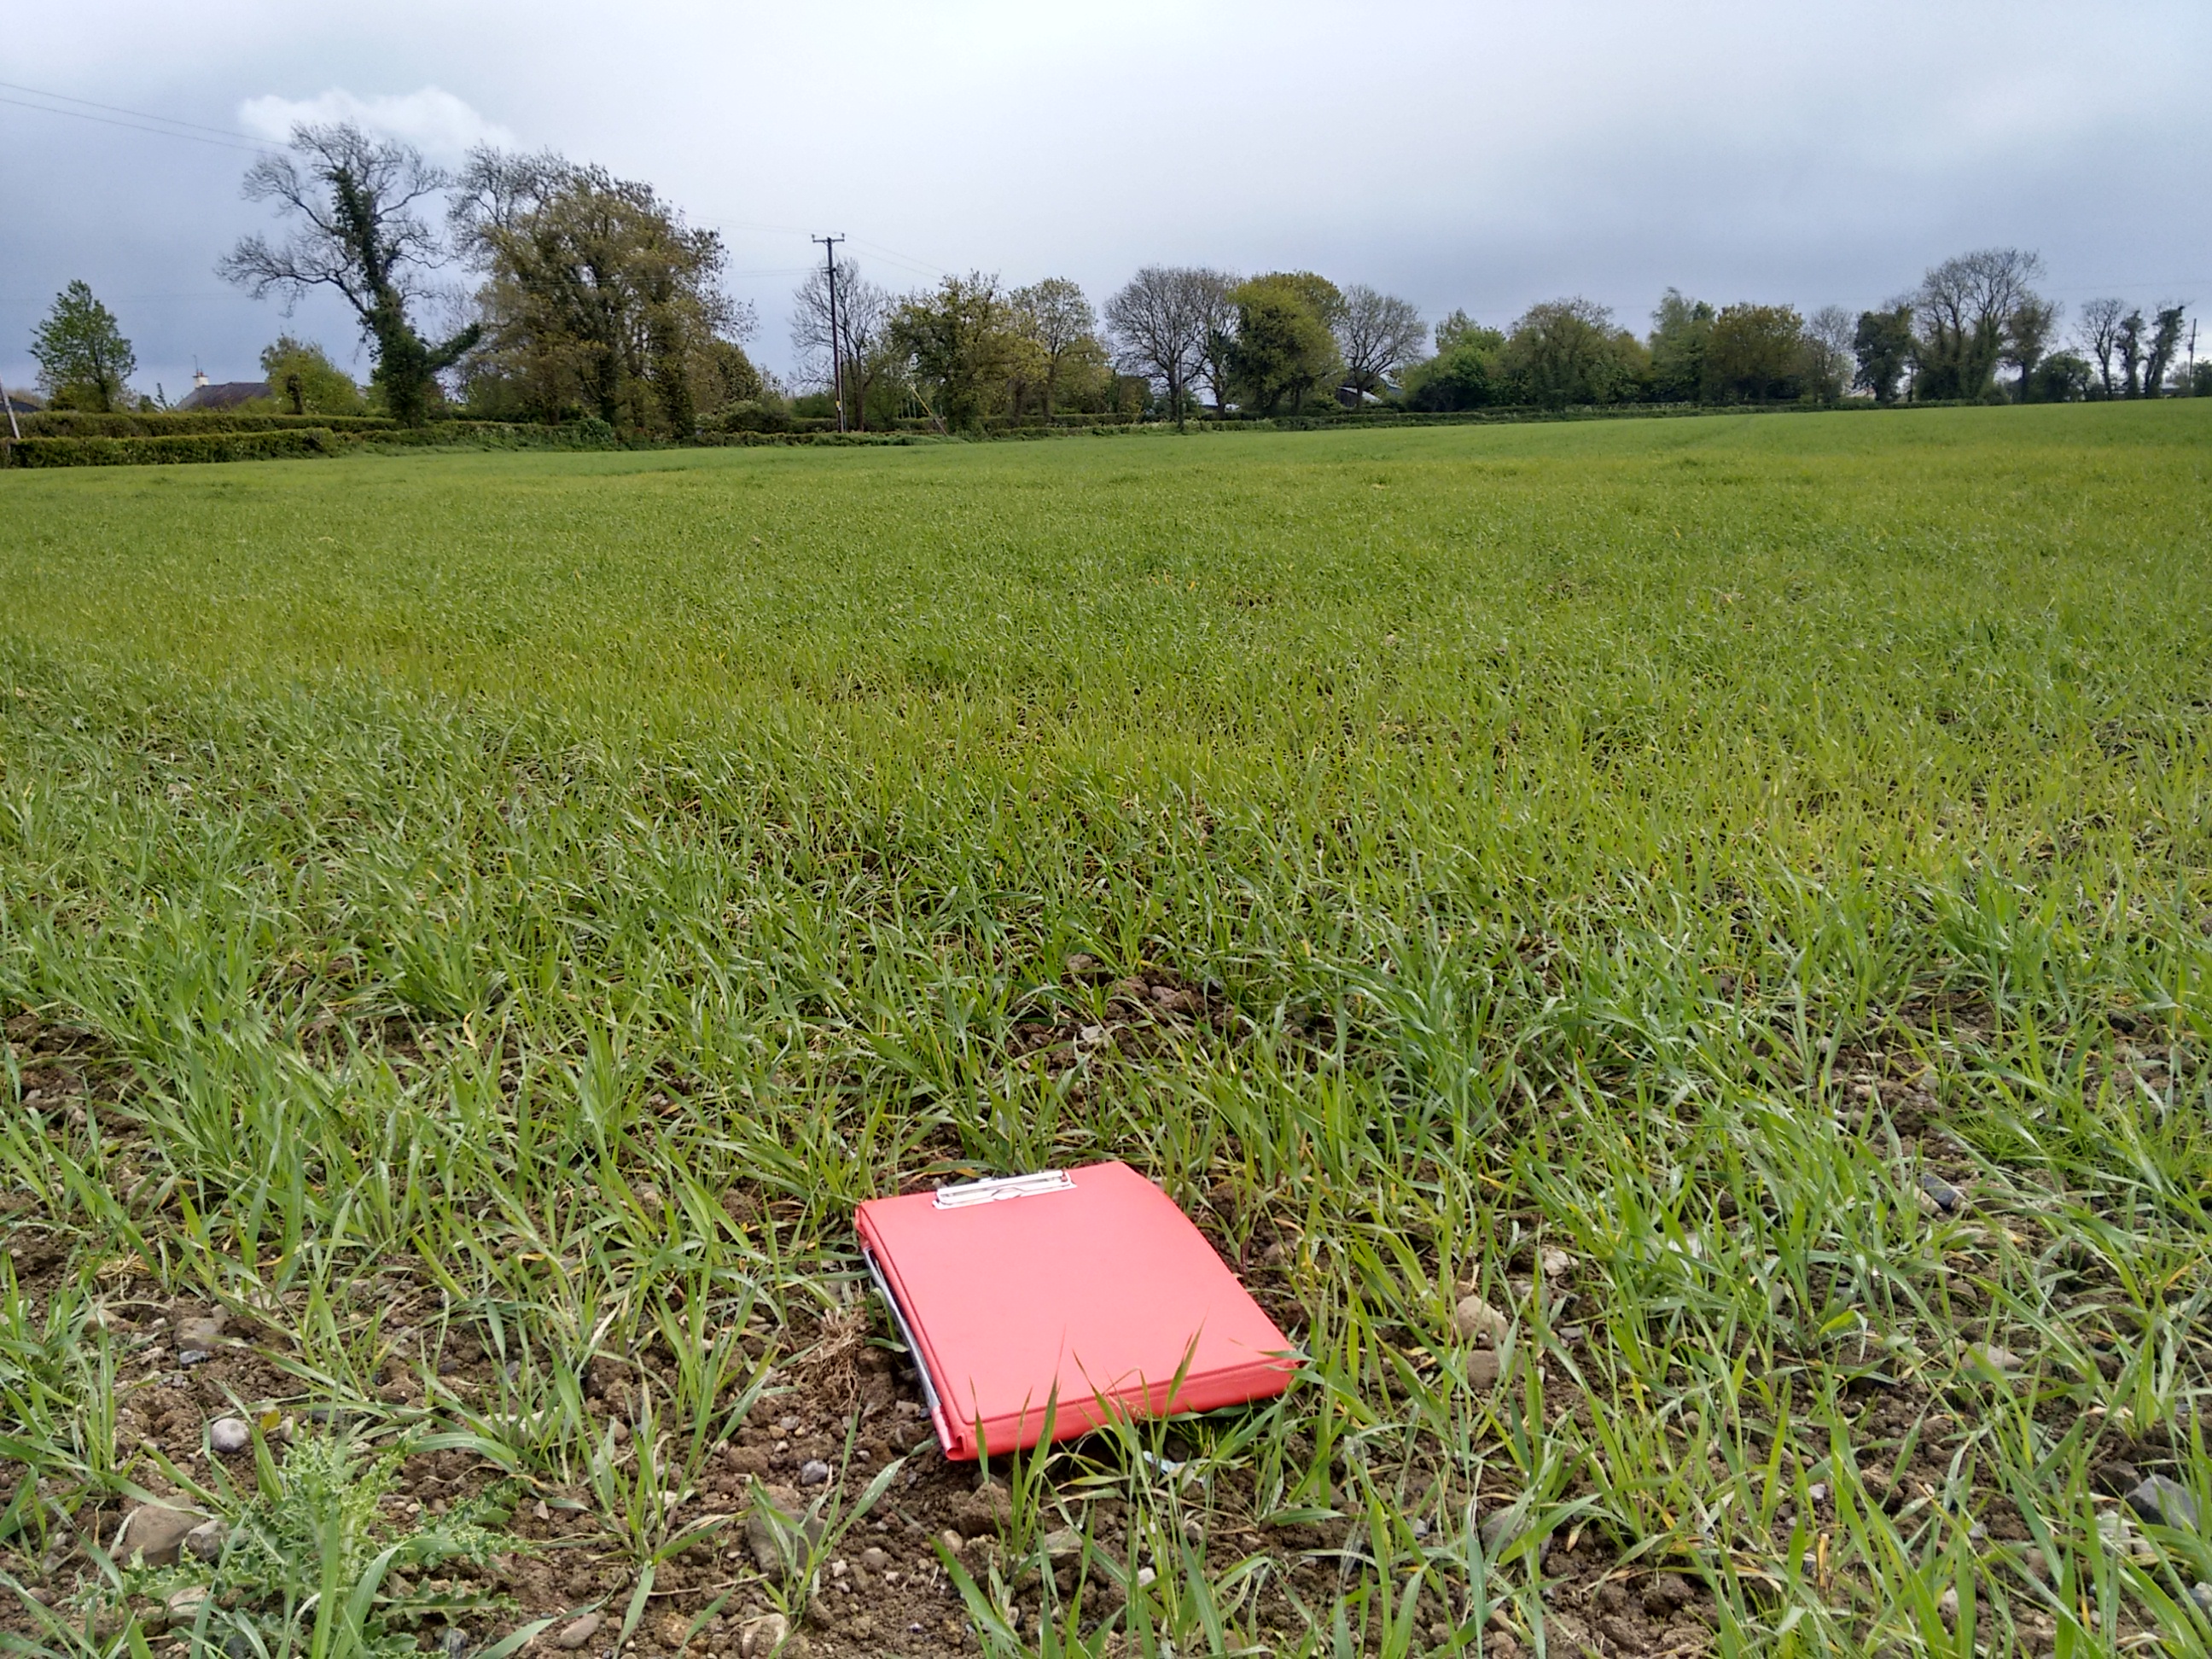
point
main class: Cropland
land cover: Barley
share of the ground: 50 - 75 %
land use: Agriculture (excluding fallow land and kitchen gardens)
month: May
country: IE
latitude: 53.3421
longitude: -6.6376
